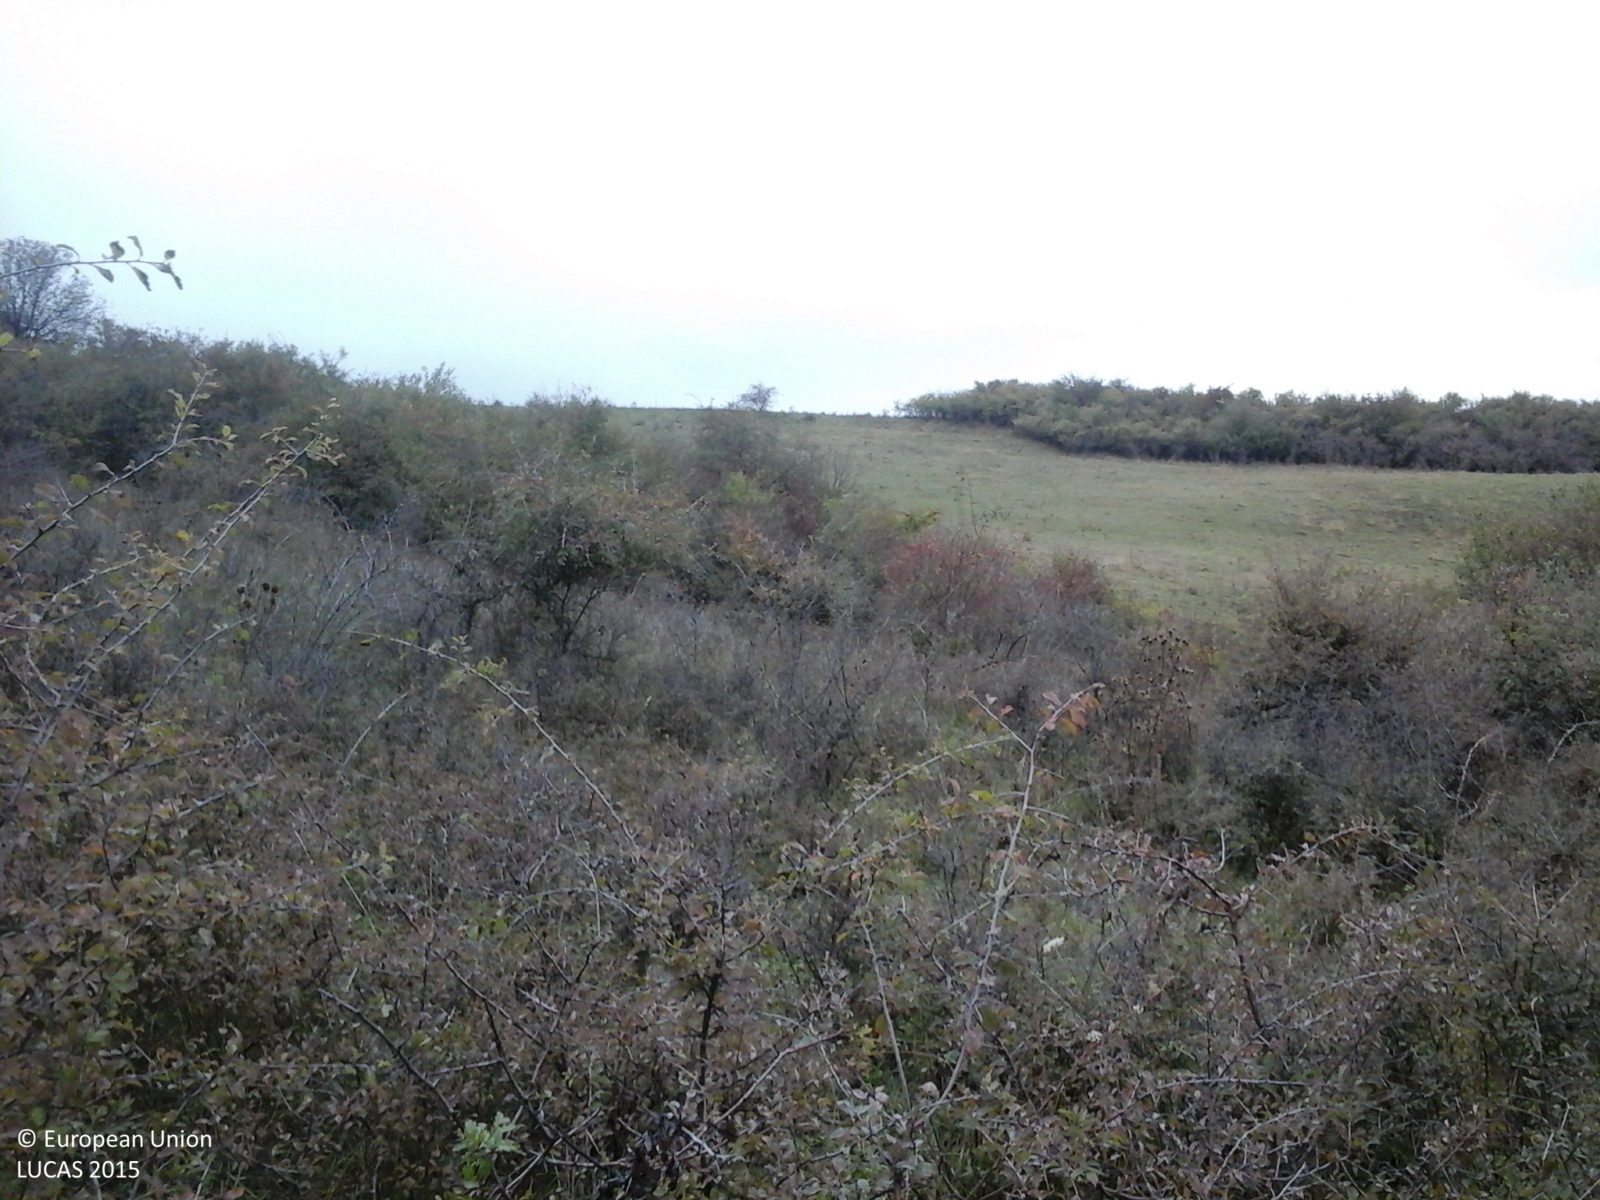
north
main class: Shrubland
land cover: Shrubland without tree cover
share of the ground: > 75 %
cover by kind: herbaceous plants 90 %, shrubs 10 %
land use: Semi-natural and natural areas not in use
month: October
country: RO
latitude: 45.8646
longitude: 24.1282
